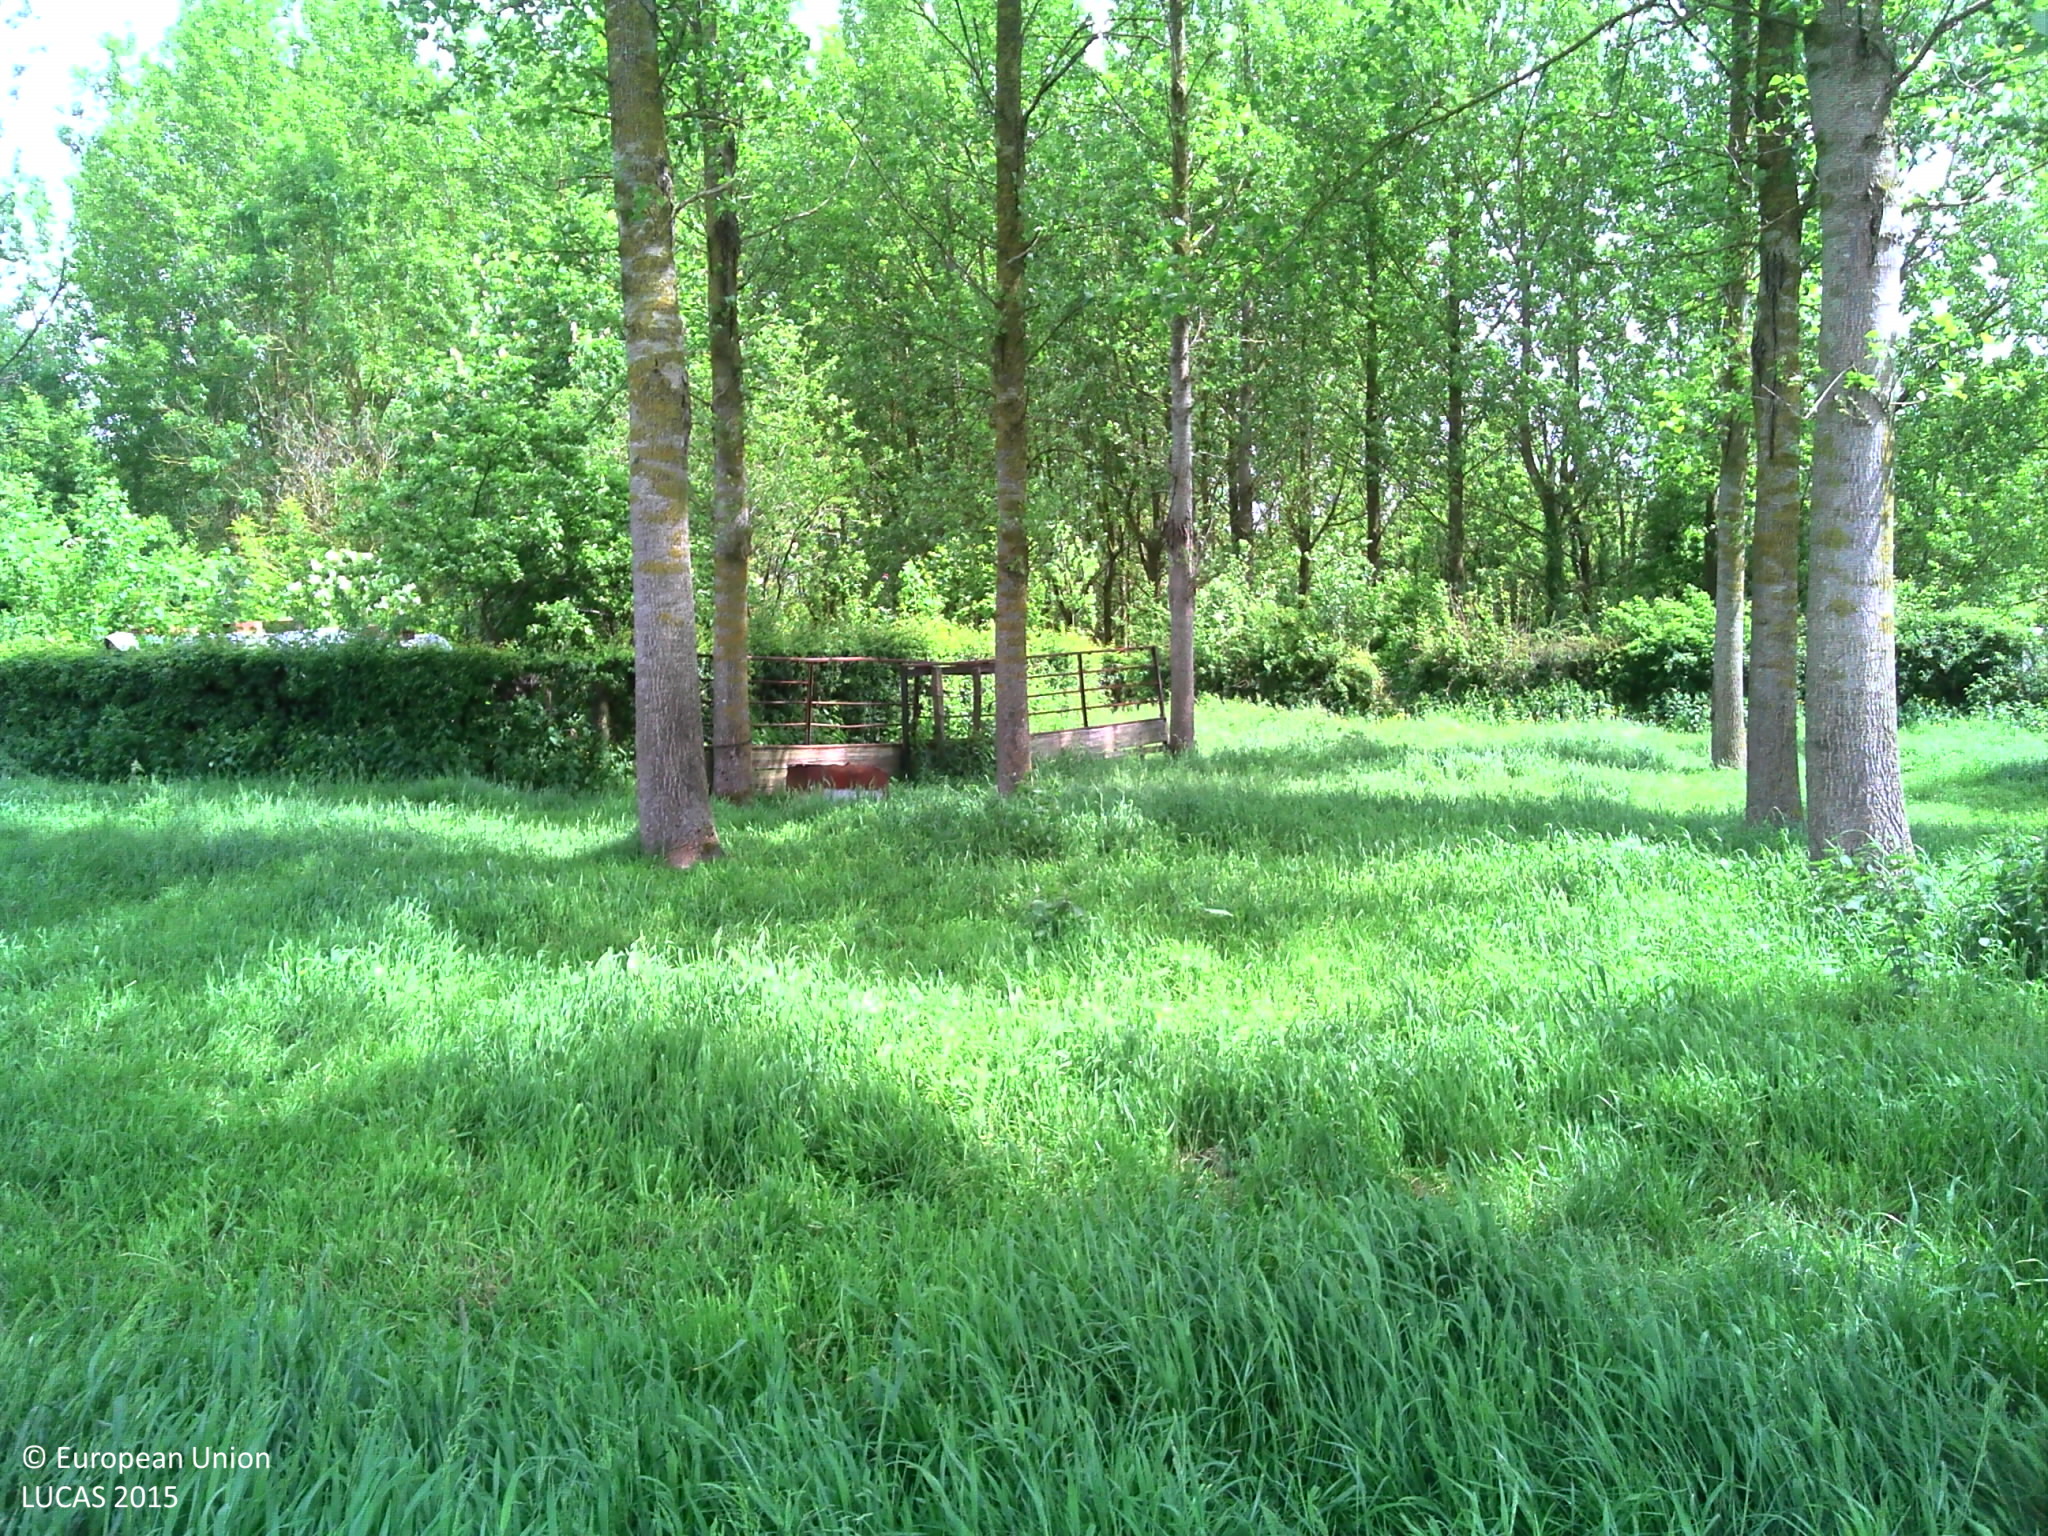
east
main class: Woodland
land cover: Broadleaved woodland
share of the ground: 50 - 75 %
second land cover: Grassland without tree/shrub cover
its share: 25 - 50 %
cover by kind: broadleaved forest trees 70 %, herbaceous plants 30 %
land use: Forestry
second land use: Agriculture (excluding fallow land and kitchen gardens)
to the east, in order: Broadleaved woodland; Grassland without tree/shrub cover; Fences; Managed hedges; Tracks; Broadleaved woodland; Fences; Grassland without tree/shrub cover; Fences; Broadleaved woodland; Fences; Grassland without tree/shrub cover; Managed hedges; Grassland without tree/shrub cover
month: May
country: FR
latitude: 50.5816
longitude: 2.1471
